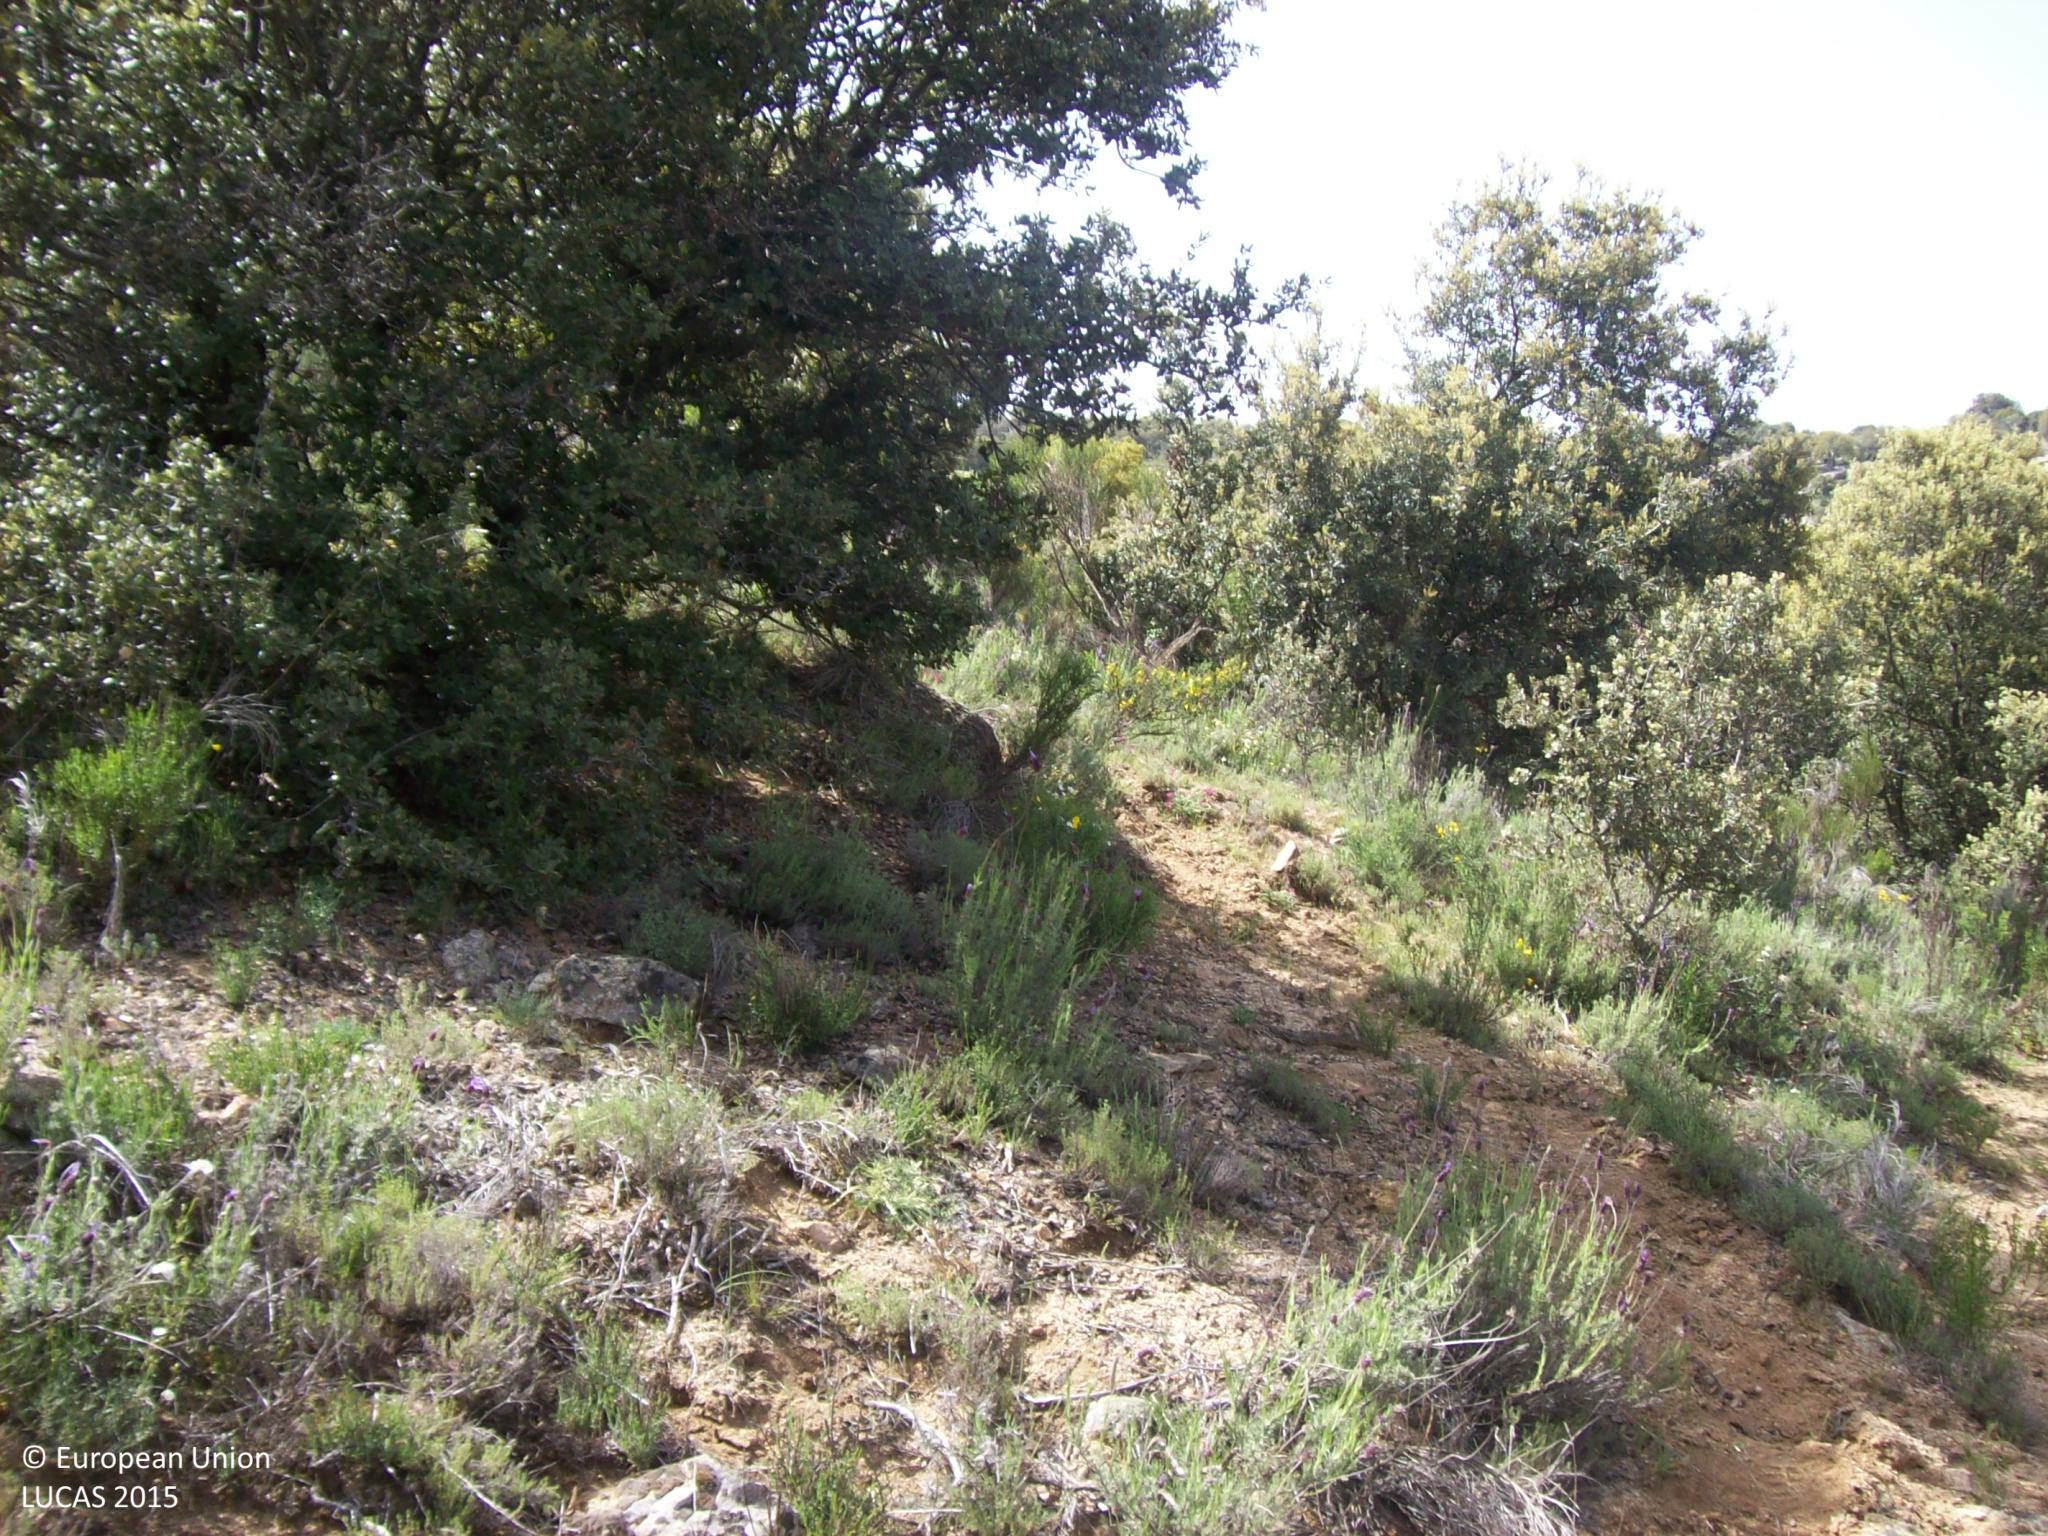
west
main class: Woodland
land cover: Broadleaved woodland
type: broadleaved evergreen forest
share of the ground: 25 - 50 %
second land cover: Shrubland without tree cover
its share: 10 - 25 %
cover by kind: broadleaved forest trees 40 %, shrubs 20 %, unconsolidated bare surface 20 %, herbaceous plants 10 %, consolidated bare surface 10 %
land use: Forestry
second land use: Agriculture (excluding fallow land and kitchen gardens)
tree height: < 5 m
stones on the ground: 10 - 25 %
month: May
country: ES
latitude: 40.6320
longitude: -4.8723
